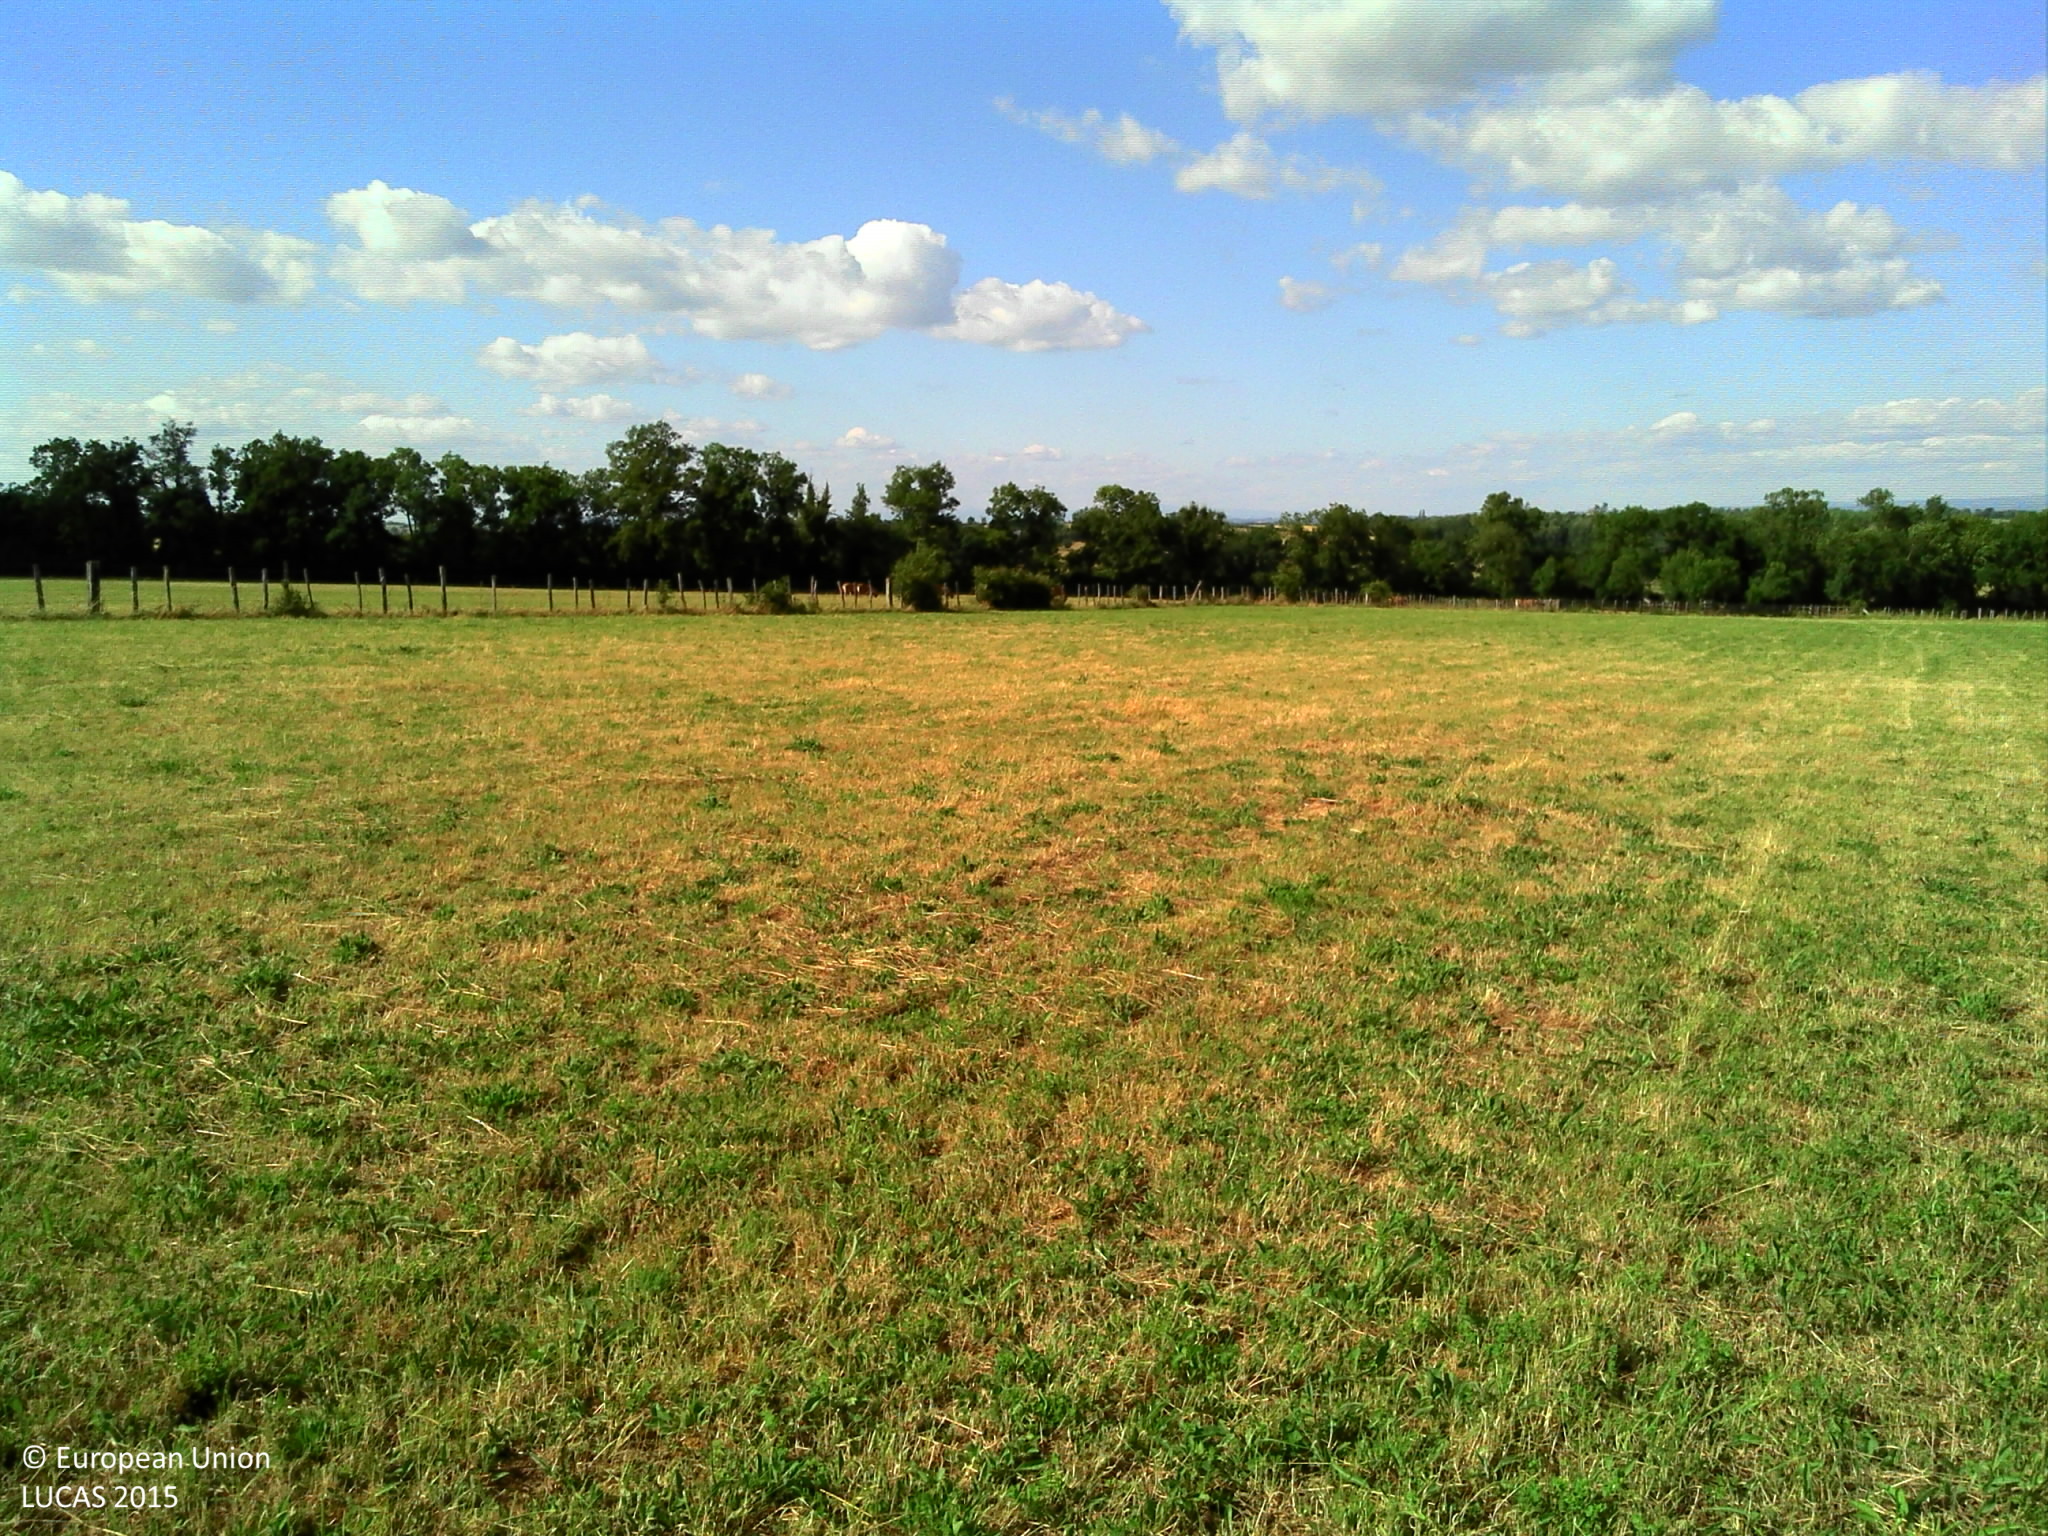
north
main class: Grassland
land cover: Grassland without tree/shrub cover
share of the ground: > 75 %
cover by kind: herbaceous plants 100 %
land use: Agriculture (excluding fallow land and kitchen gardens)
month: June
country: FR
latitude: 44.3676
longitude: 2.4864
